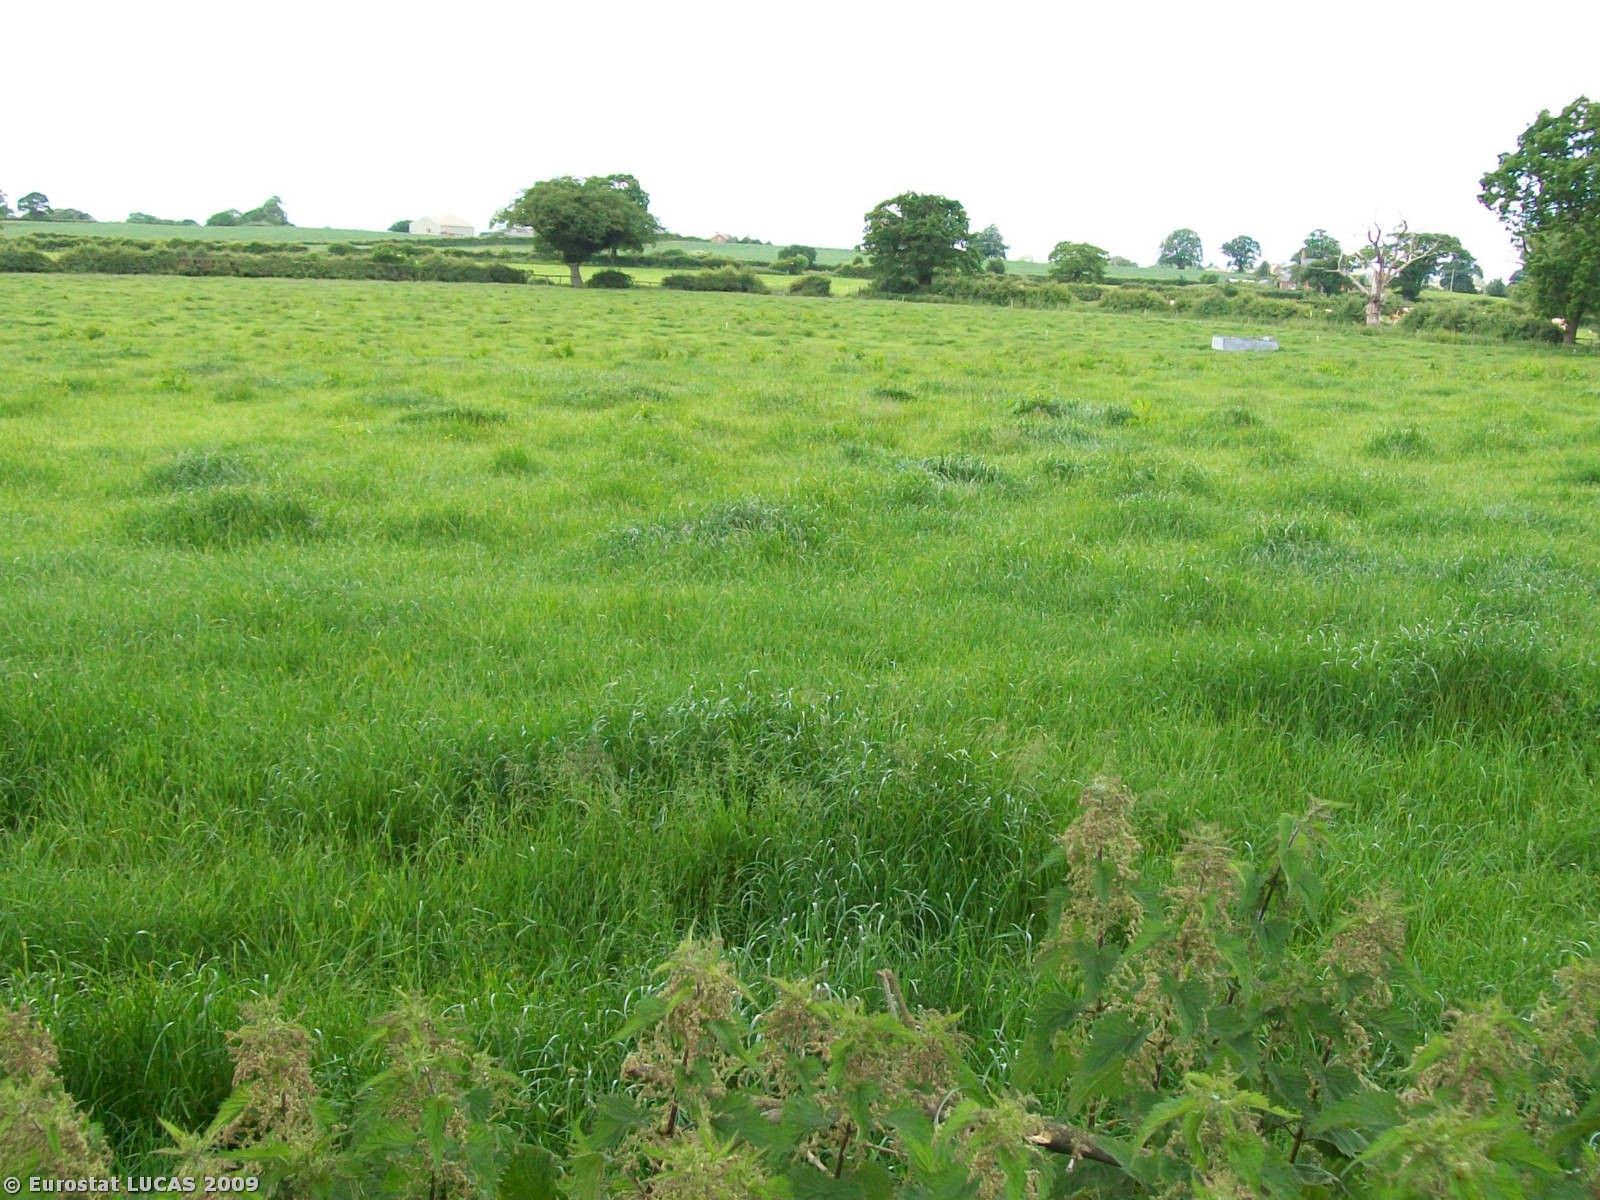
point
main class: Grassland
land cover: Grassland without tree/shrub cover
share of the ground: > 75 %
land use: Agriculture (excluding fallow land and kitchen gardens)
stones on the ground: < 10 %
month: June
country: GB
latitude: 52.9395
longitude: -2.6116
